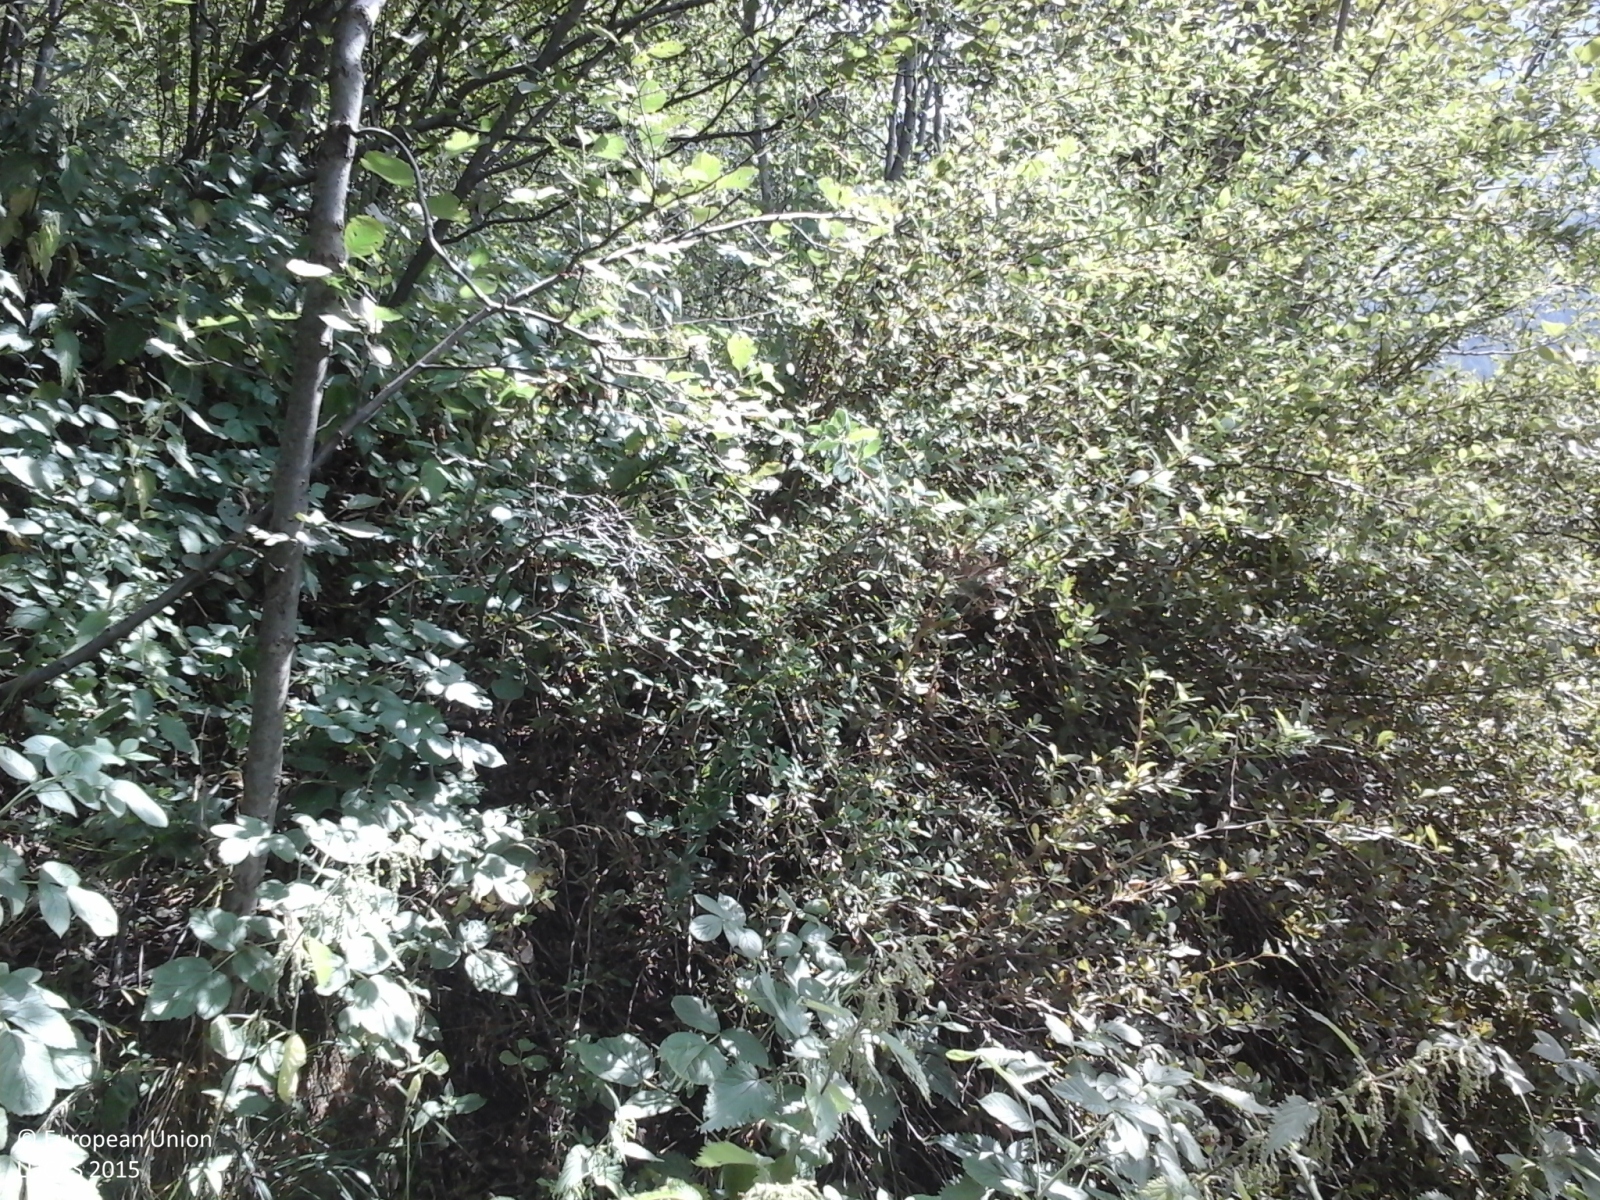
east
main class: Woodland
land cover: Other mixed woodland
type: mesophytic deciduous forest
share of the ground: > 75 %
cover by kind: broadleaved forest trees 75 %, coniferous forest trees 25 %
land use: Semi-natural and natural areas not in use
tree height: > 5 m
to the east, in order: Other mixed woodland; Broadleaved woodland; Grassland without tree/shrub cover; Broadleaved woodland; Grassland without tree/shrub cover; Broadleaved woodland; Rocks and stones; Broadleaved woodland
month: August
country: IT
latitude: 45.6789
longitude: 7.7566
